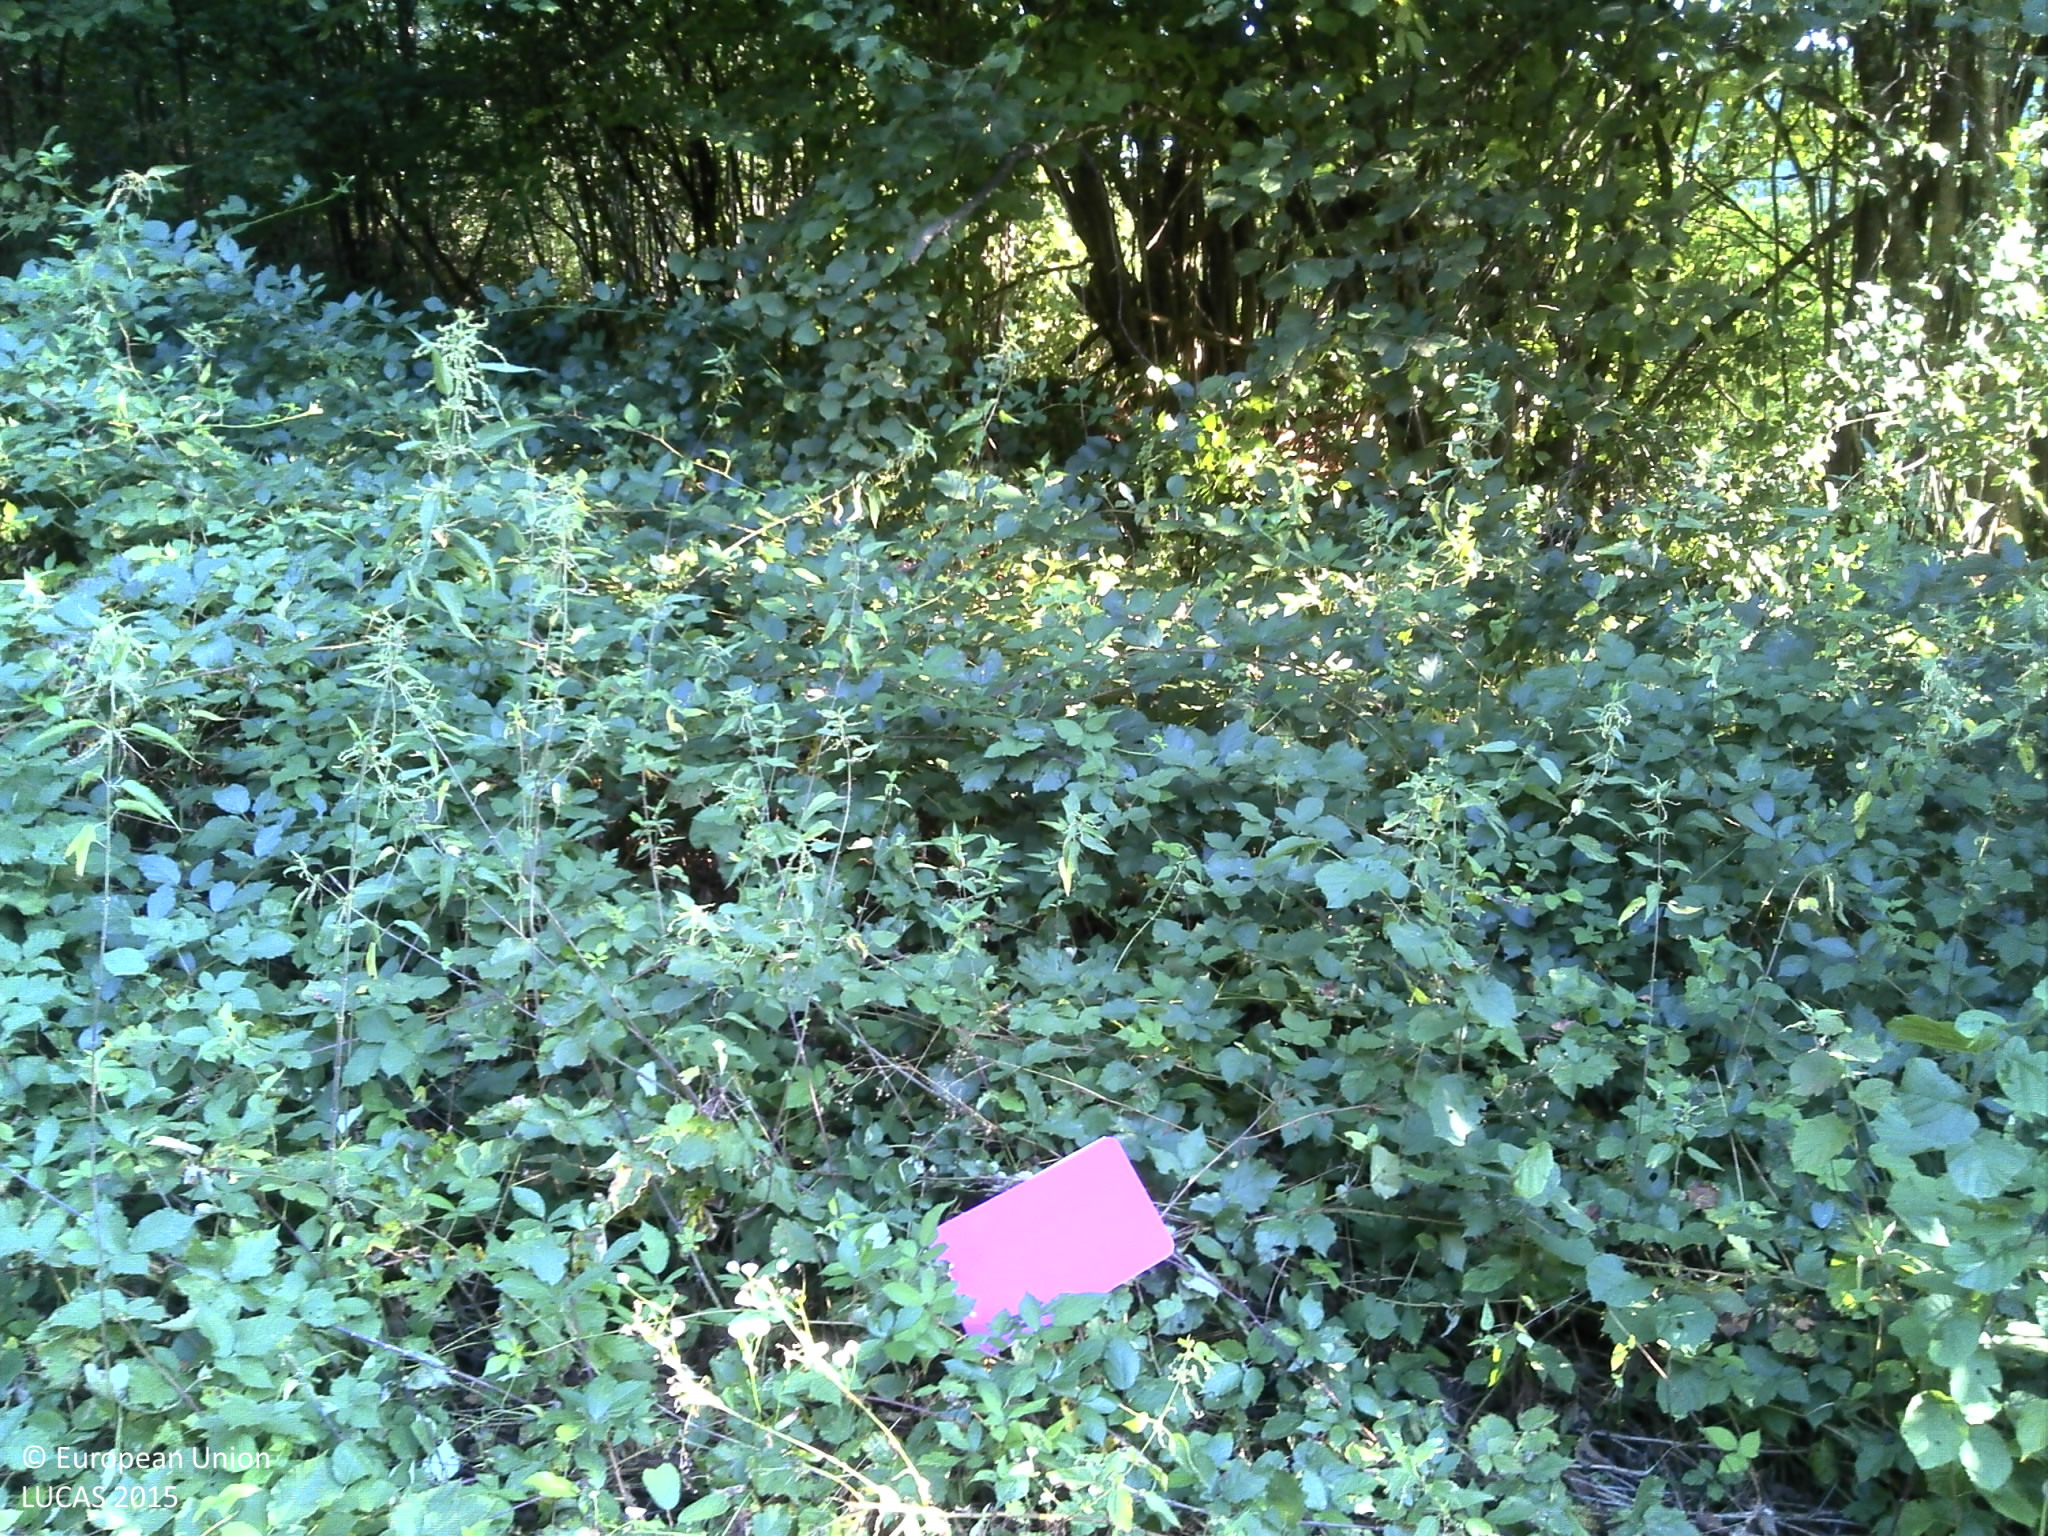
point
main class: Grassland
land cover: Spontaneously vegetated surfaces
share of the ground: > 75 %
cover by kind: herbaceous plants 100 %
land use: Forestry
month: September
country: HR
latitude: 45.3703
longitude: 15.3200
